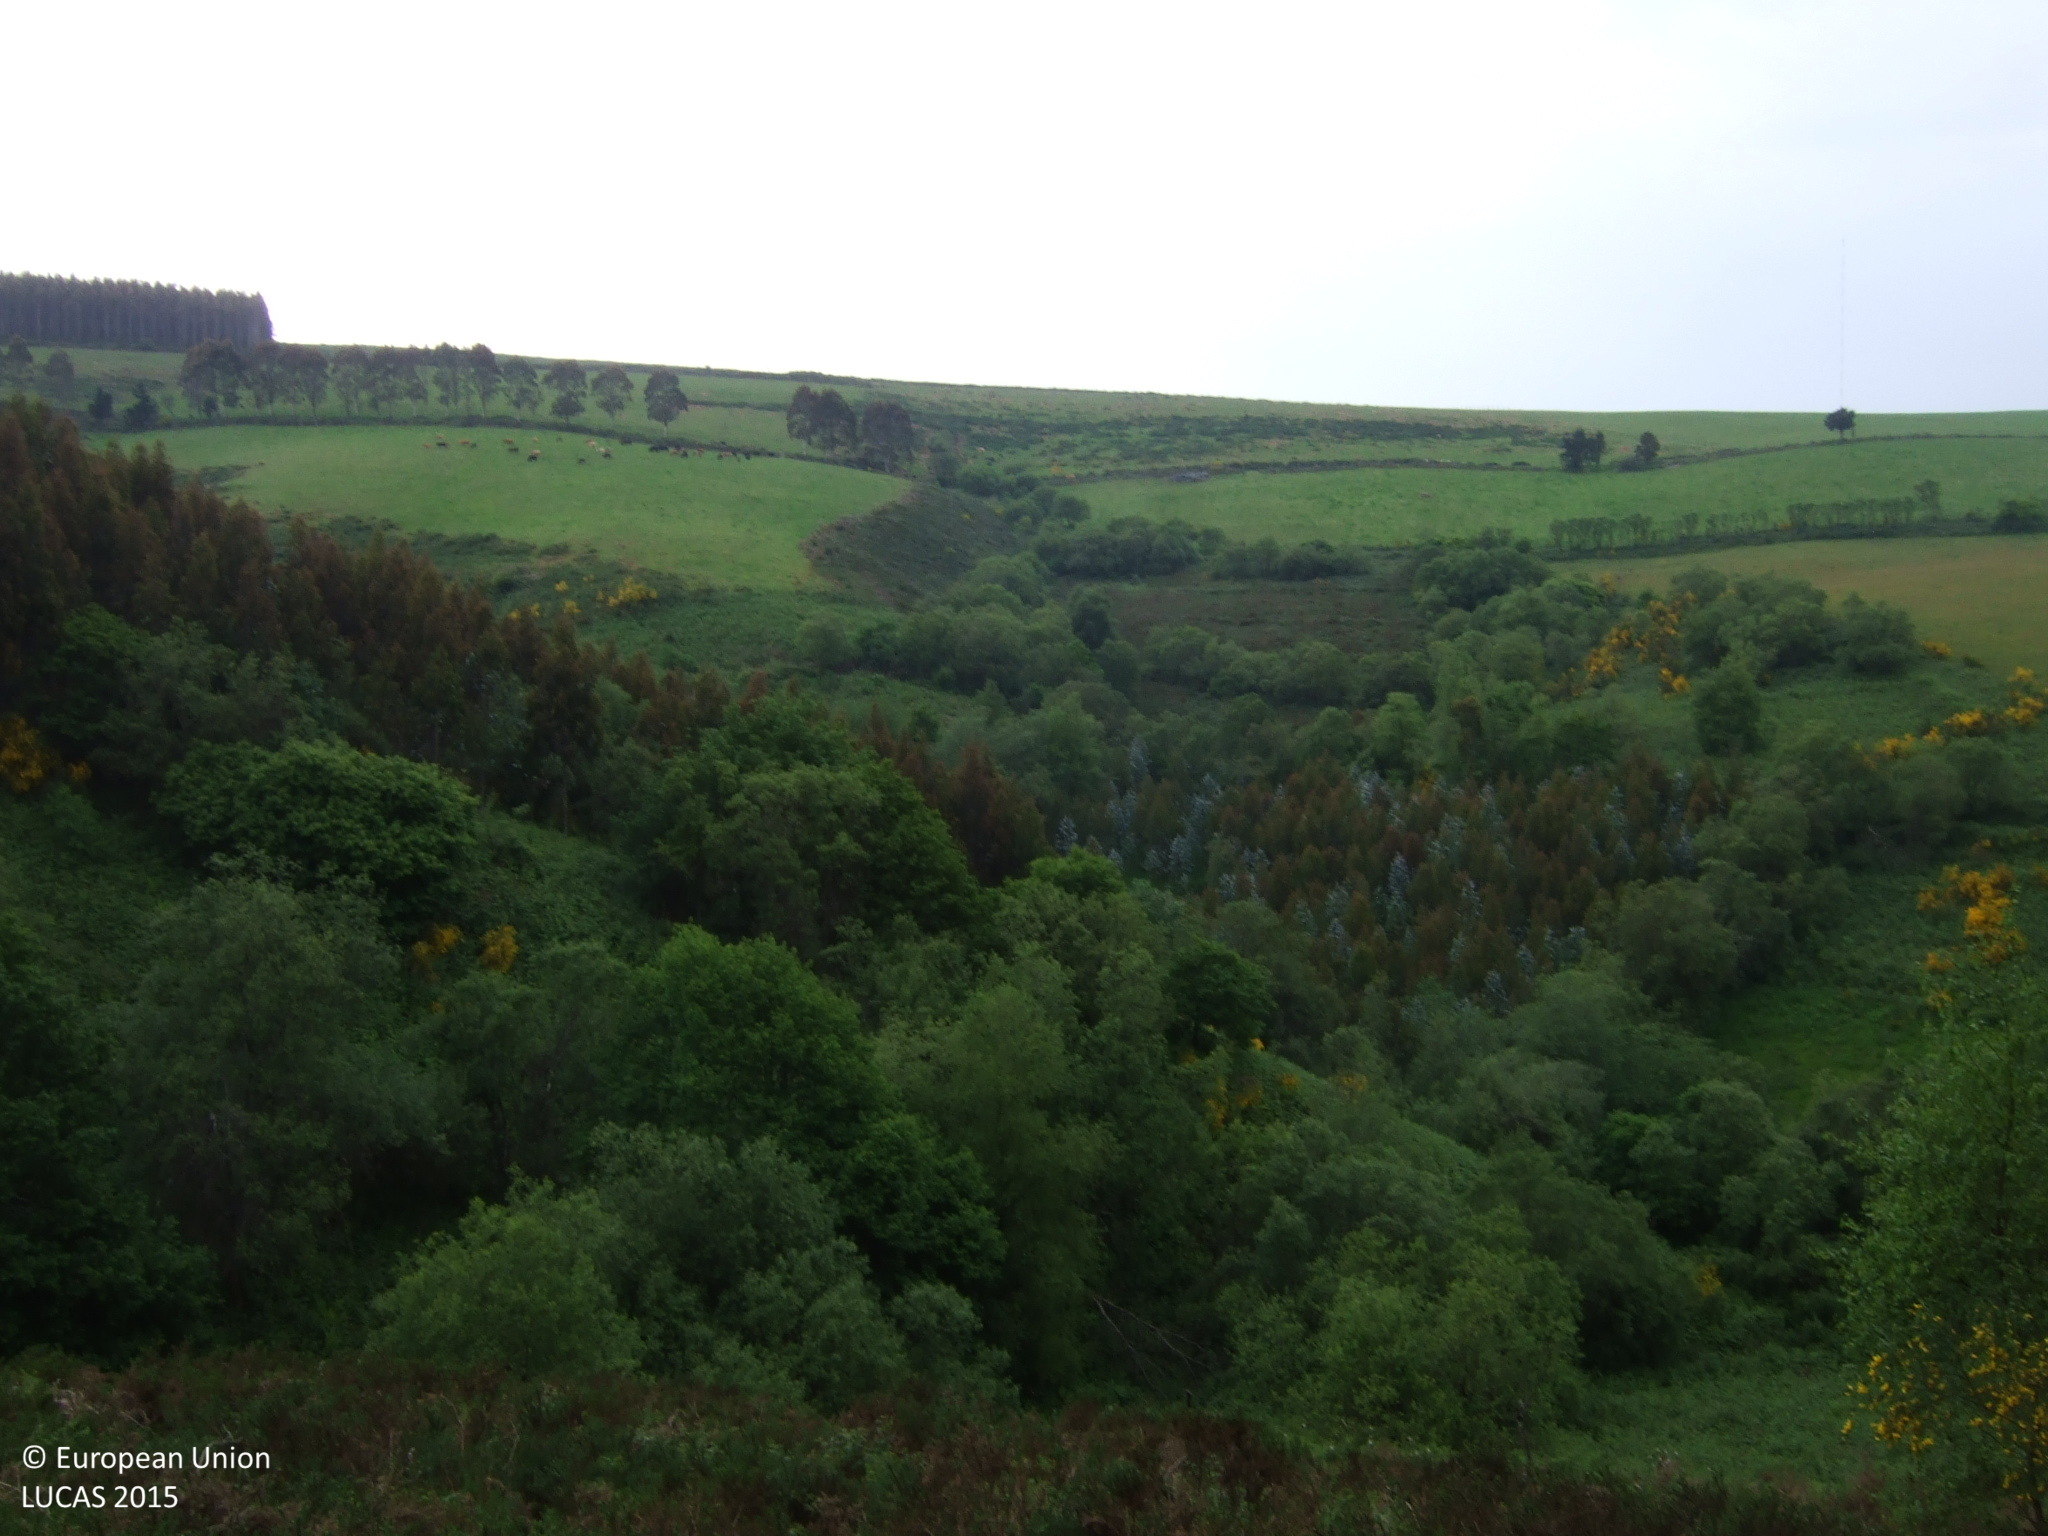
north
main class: Shrubland
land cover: Shrubland without tree cover
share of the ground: > 75 %
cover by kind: shrubs 90 %, herbaceous plants 10 %
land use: Semi-natural and natural areas not in use
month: June
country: ES
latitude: 43.3398
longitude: -7.4330
